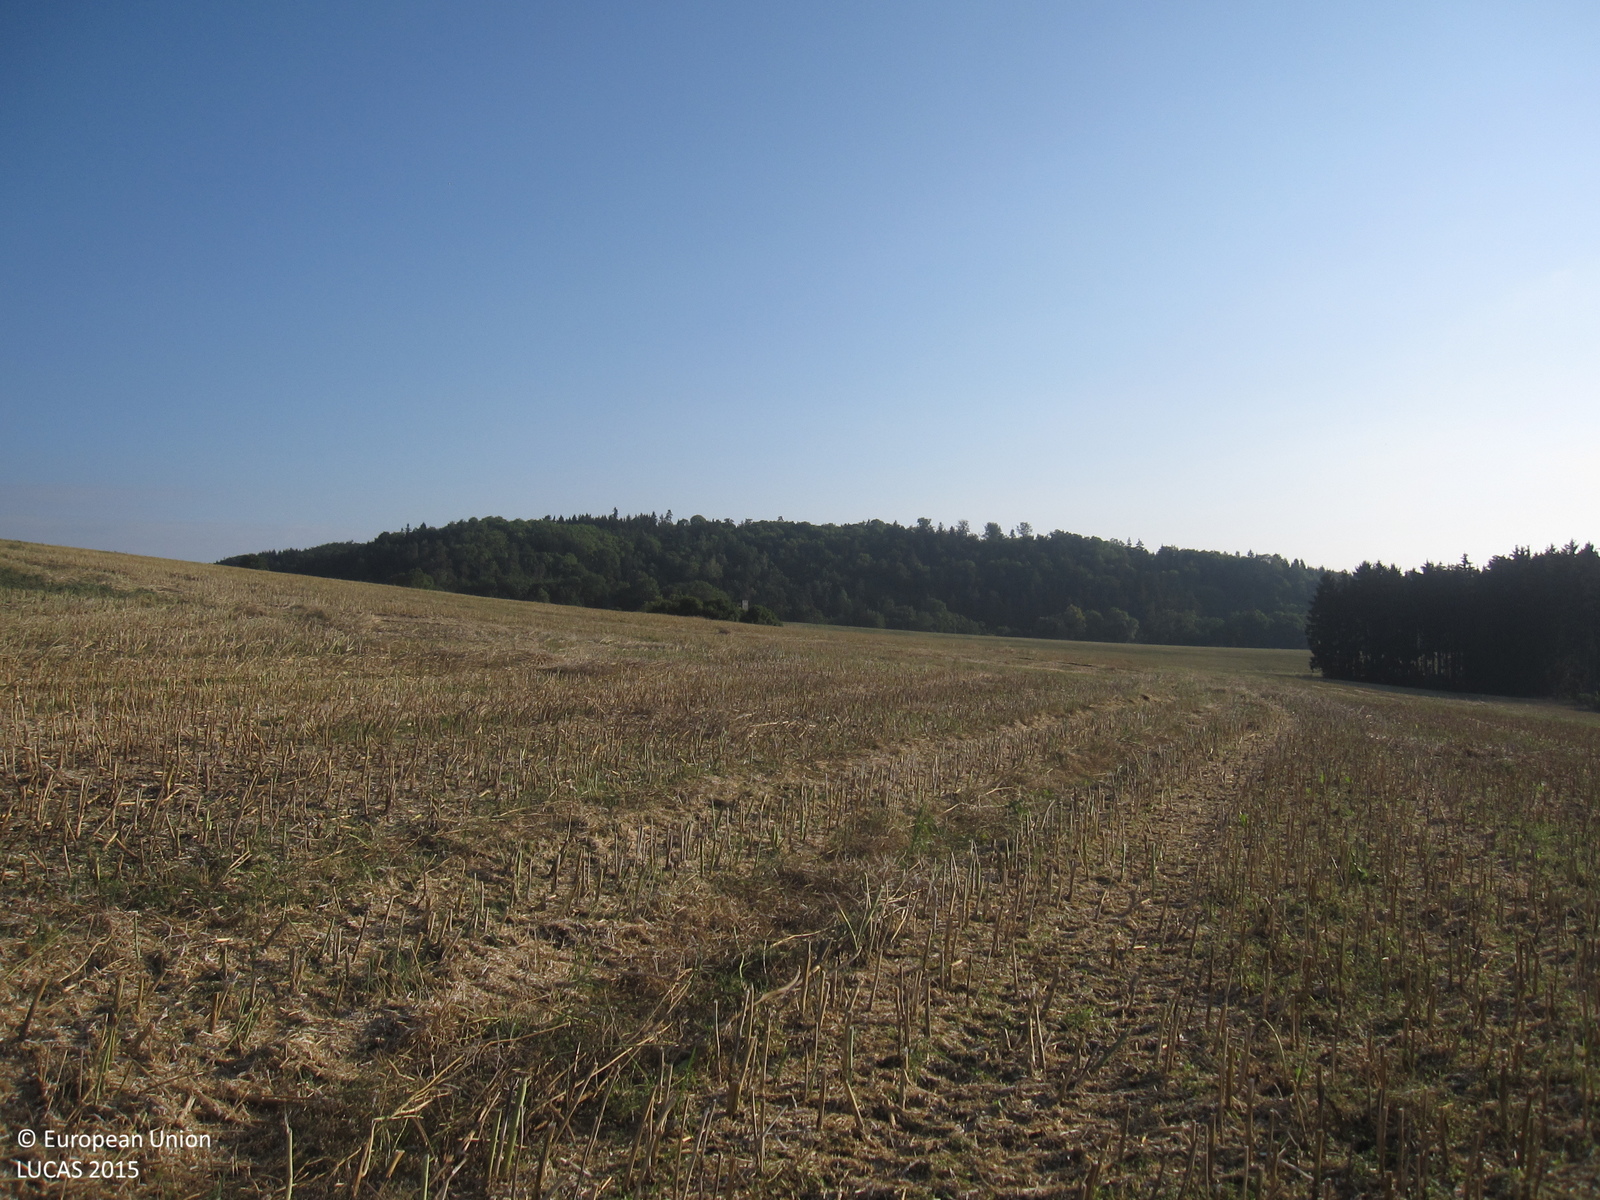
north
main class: Cropland
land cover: Rape and turnip rape
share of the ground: < 10 %
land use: Agriculture (excluding fallow land and kitchen gardens)
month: July
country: DE
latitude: 50.4178
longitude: 12.0403
